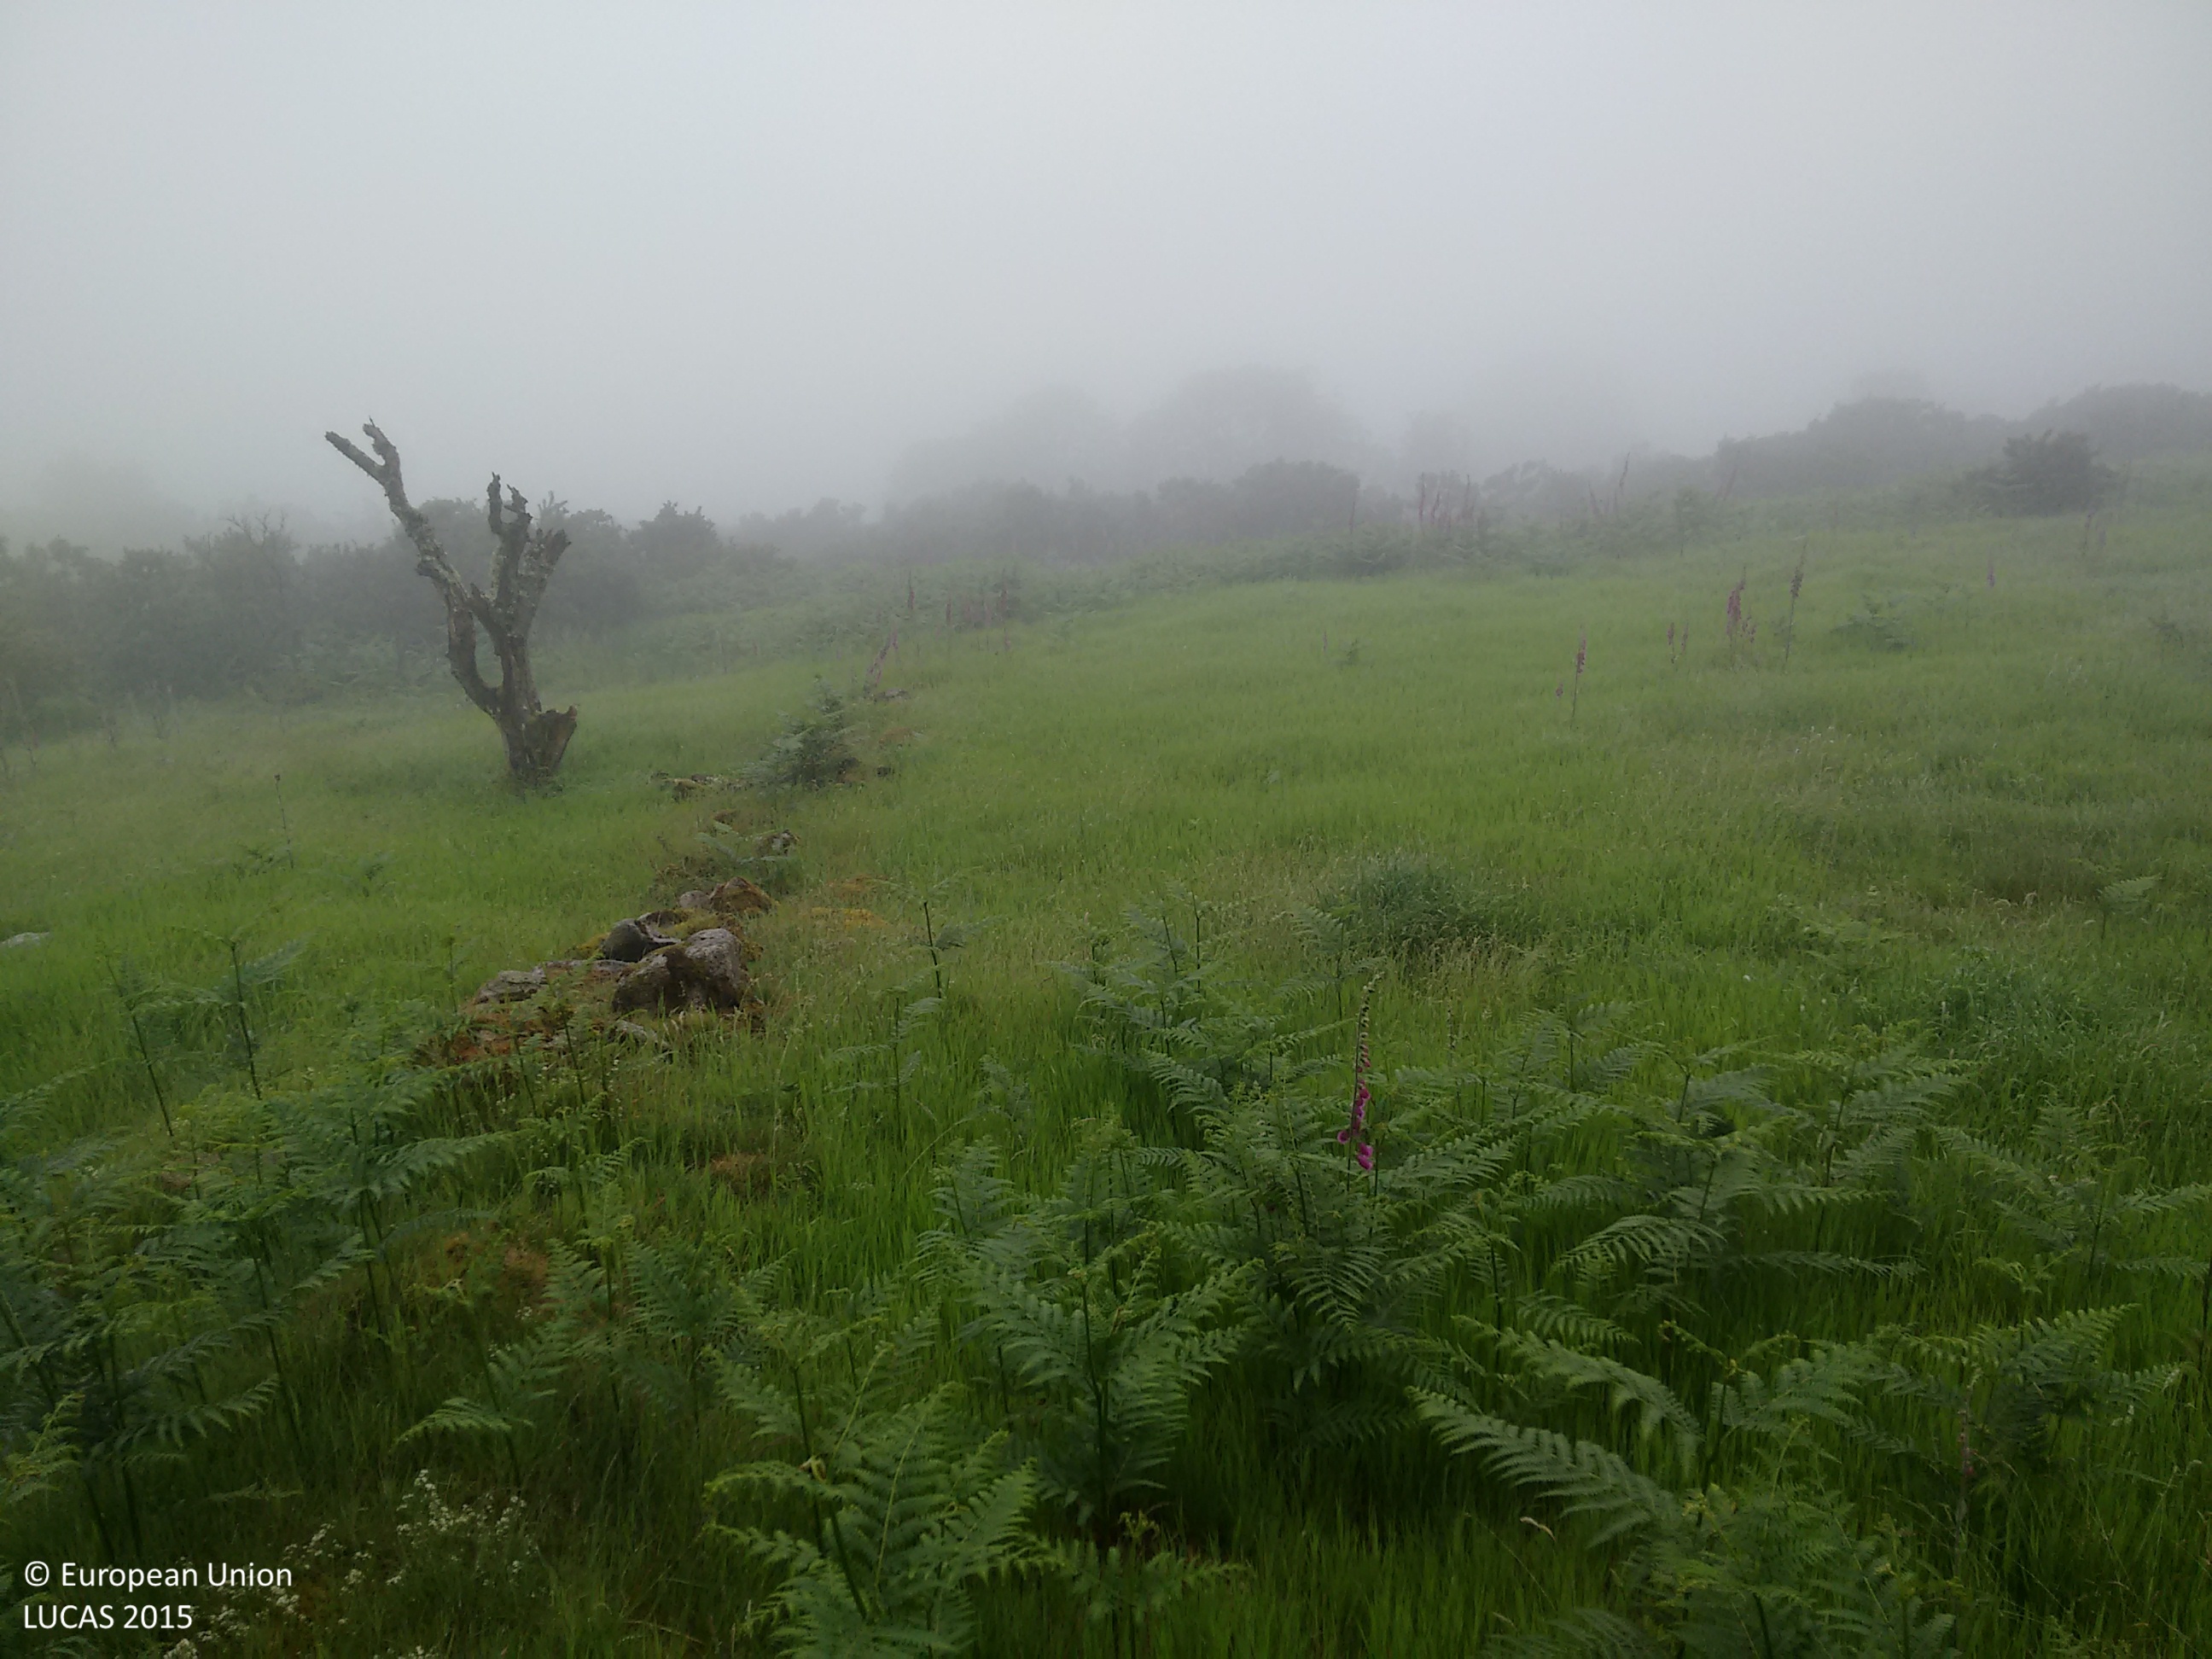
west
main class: Woodland
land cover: Spruce dominated coniferous woodland
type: exotic forest
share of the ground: > 75 %
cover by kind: coniferous forest trees 100 %
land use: Forestry
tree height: > 5 m
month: July
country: GB
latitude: 54.9214
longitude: -3.6740
